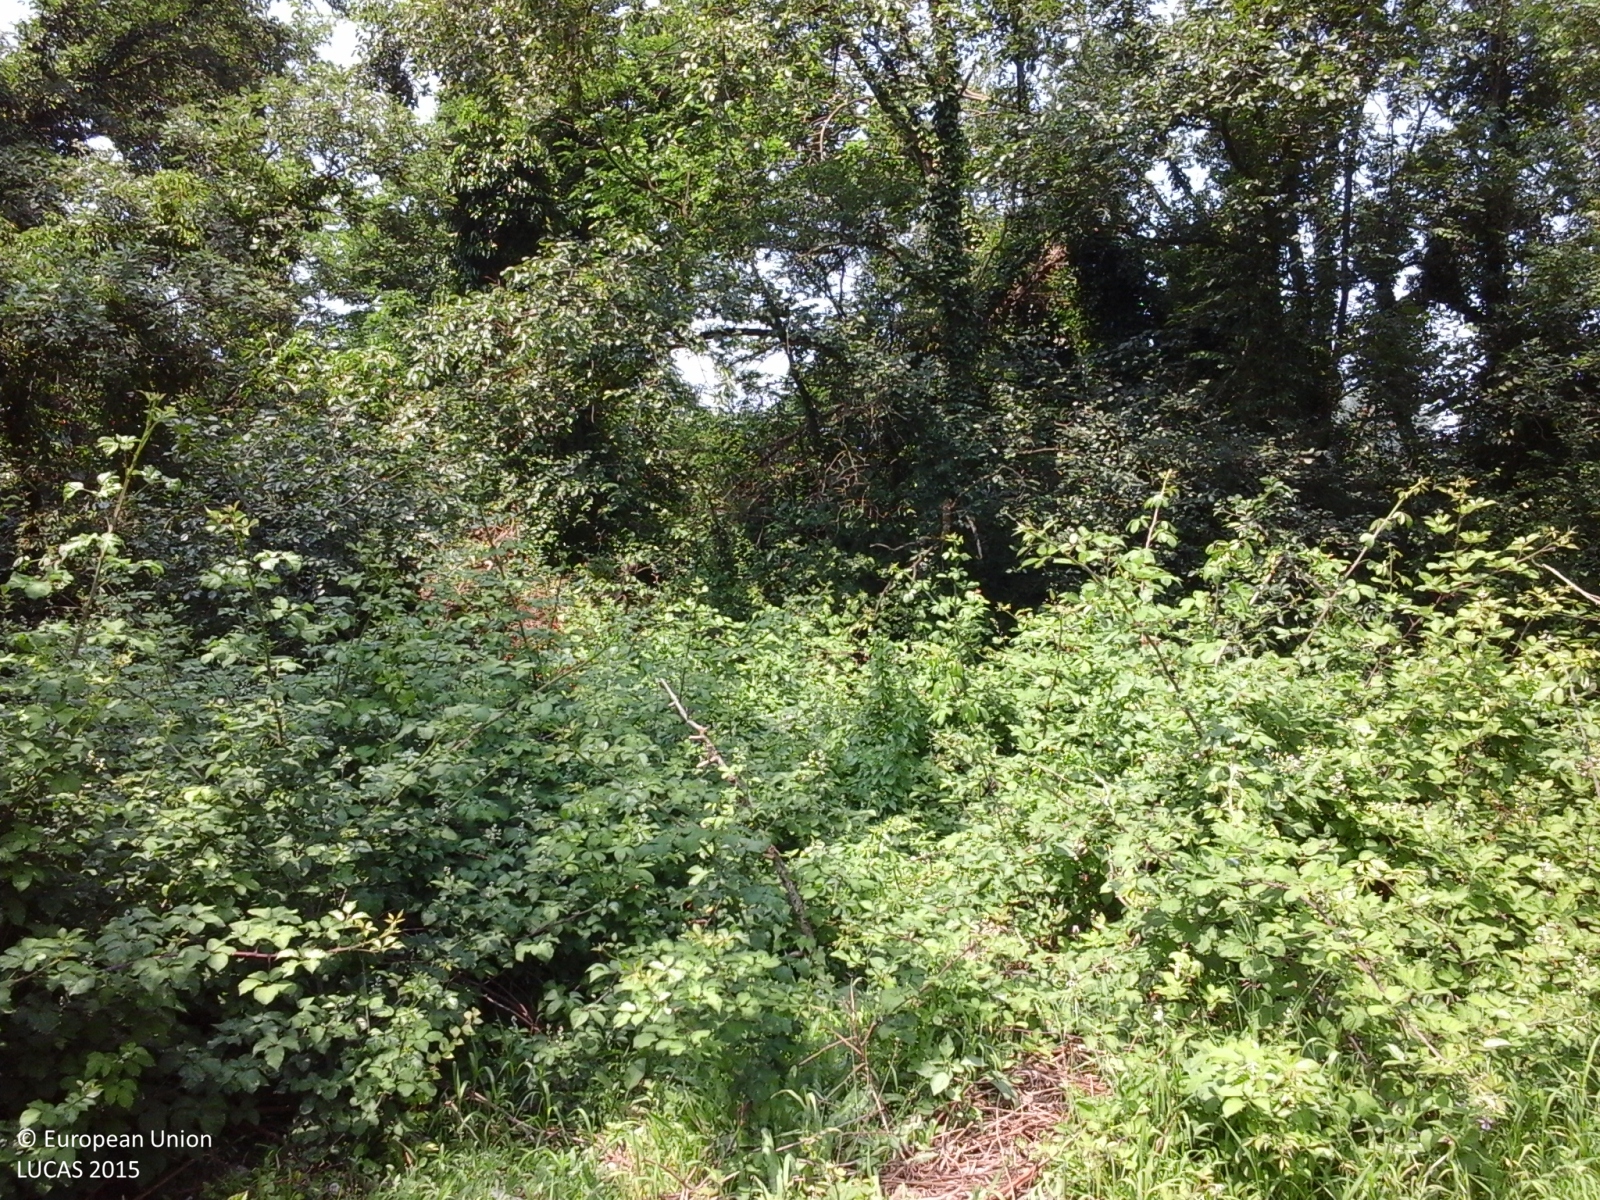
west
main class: Woodland
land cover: Broadleaved woodland
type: floodplain forest
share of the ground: > 75 %
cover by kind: broadleaved forest trees 90 %, shrubs 10 %
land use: Semi-natural and natural areas not in use
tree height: > 5 m
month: June
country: IT
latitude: 45.4323
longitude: 9.8852
